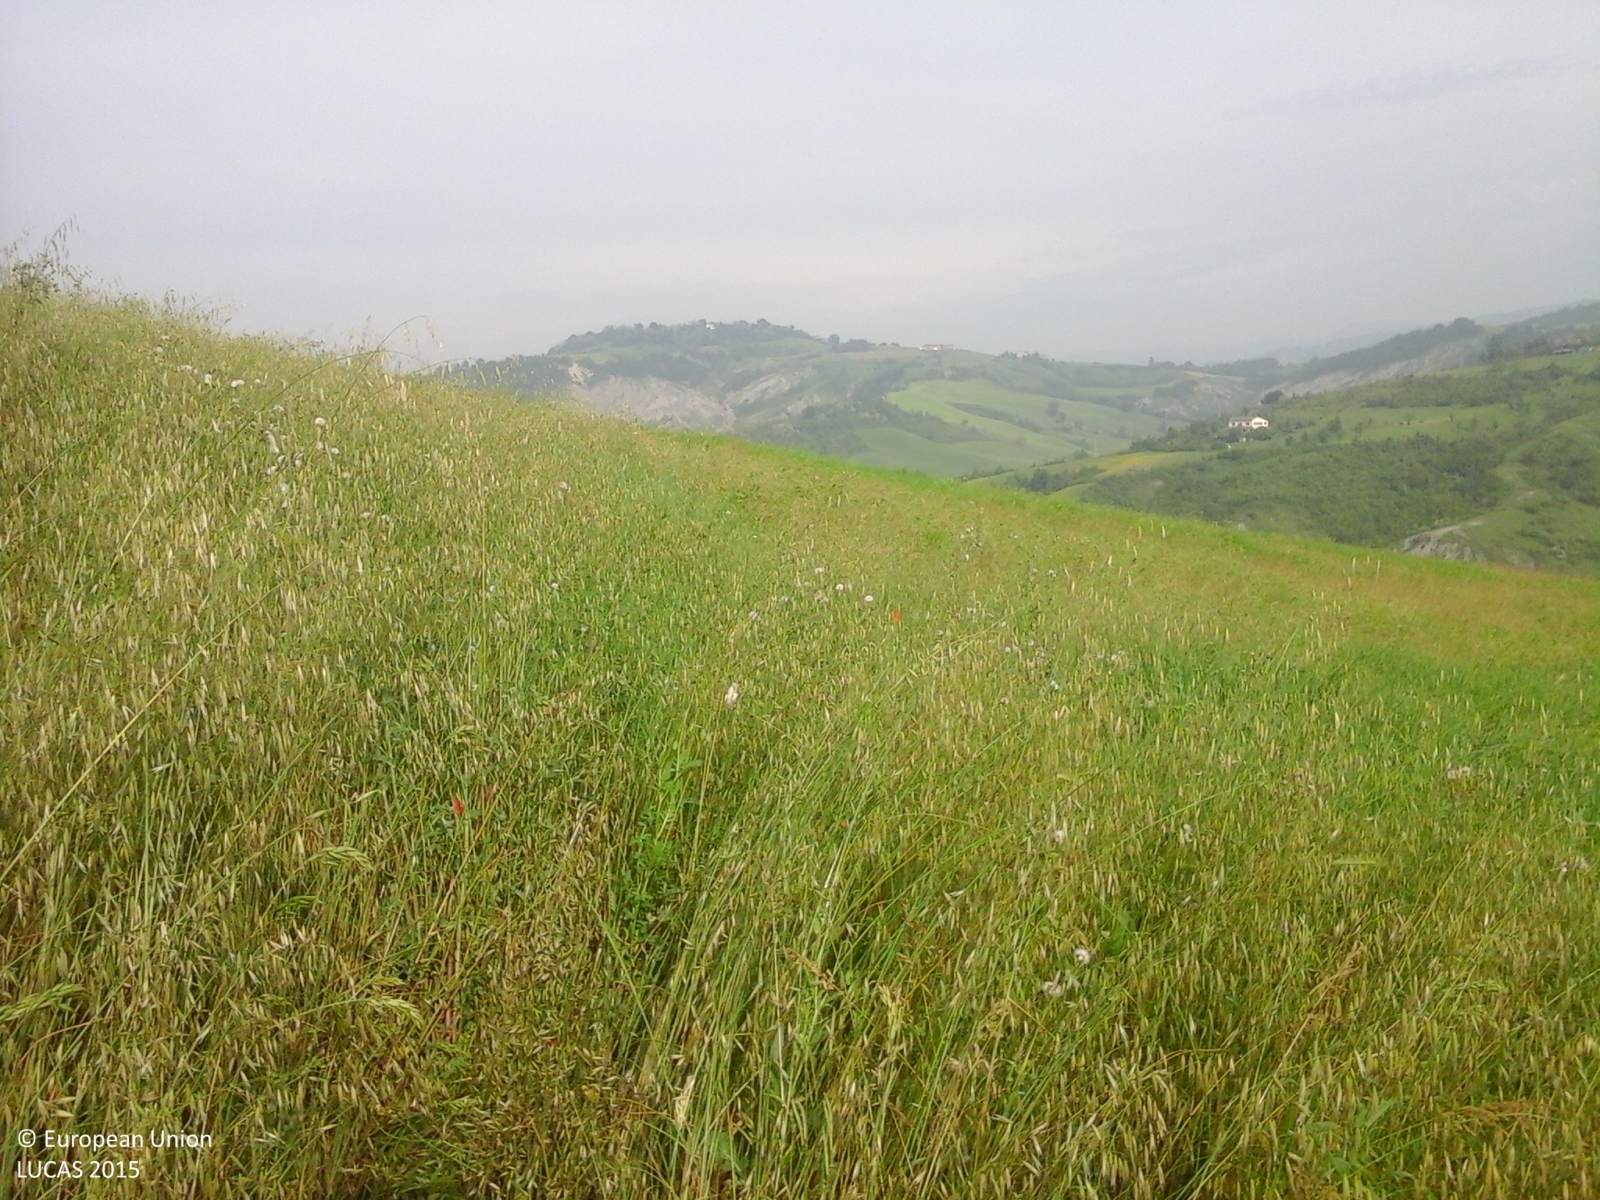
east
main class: Cropland
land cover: Lucerne
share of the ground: > 75 %
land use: Agriculture (excluding fallow land and kitchen gardens)
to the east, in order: Lucerne; Broadleaved woodland
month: May
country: IT
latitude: 44.4175
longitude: 11.0401
